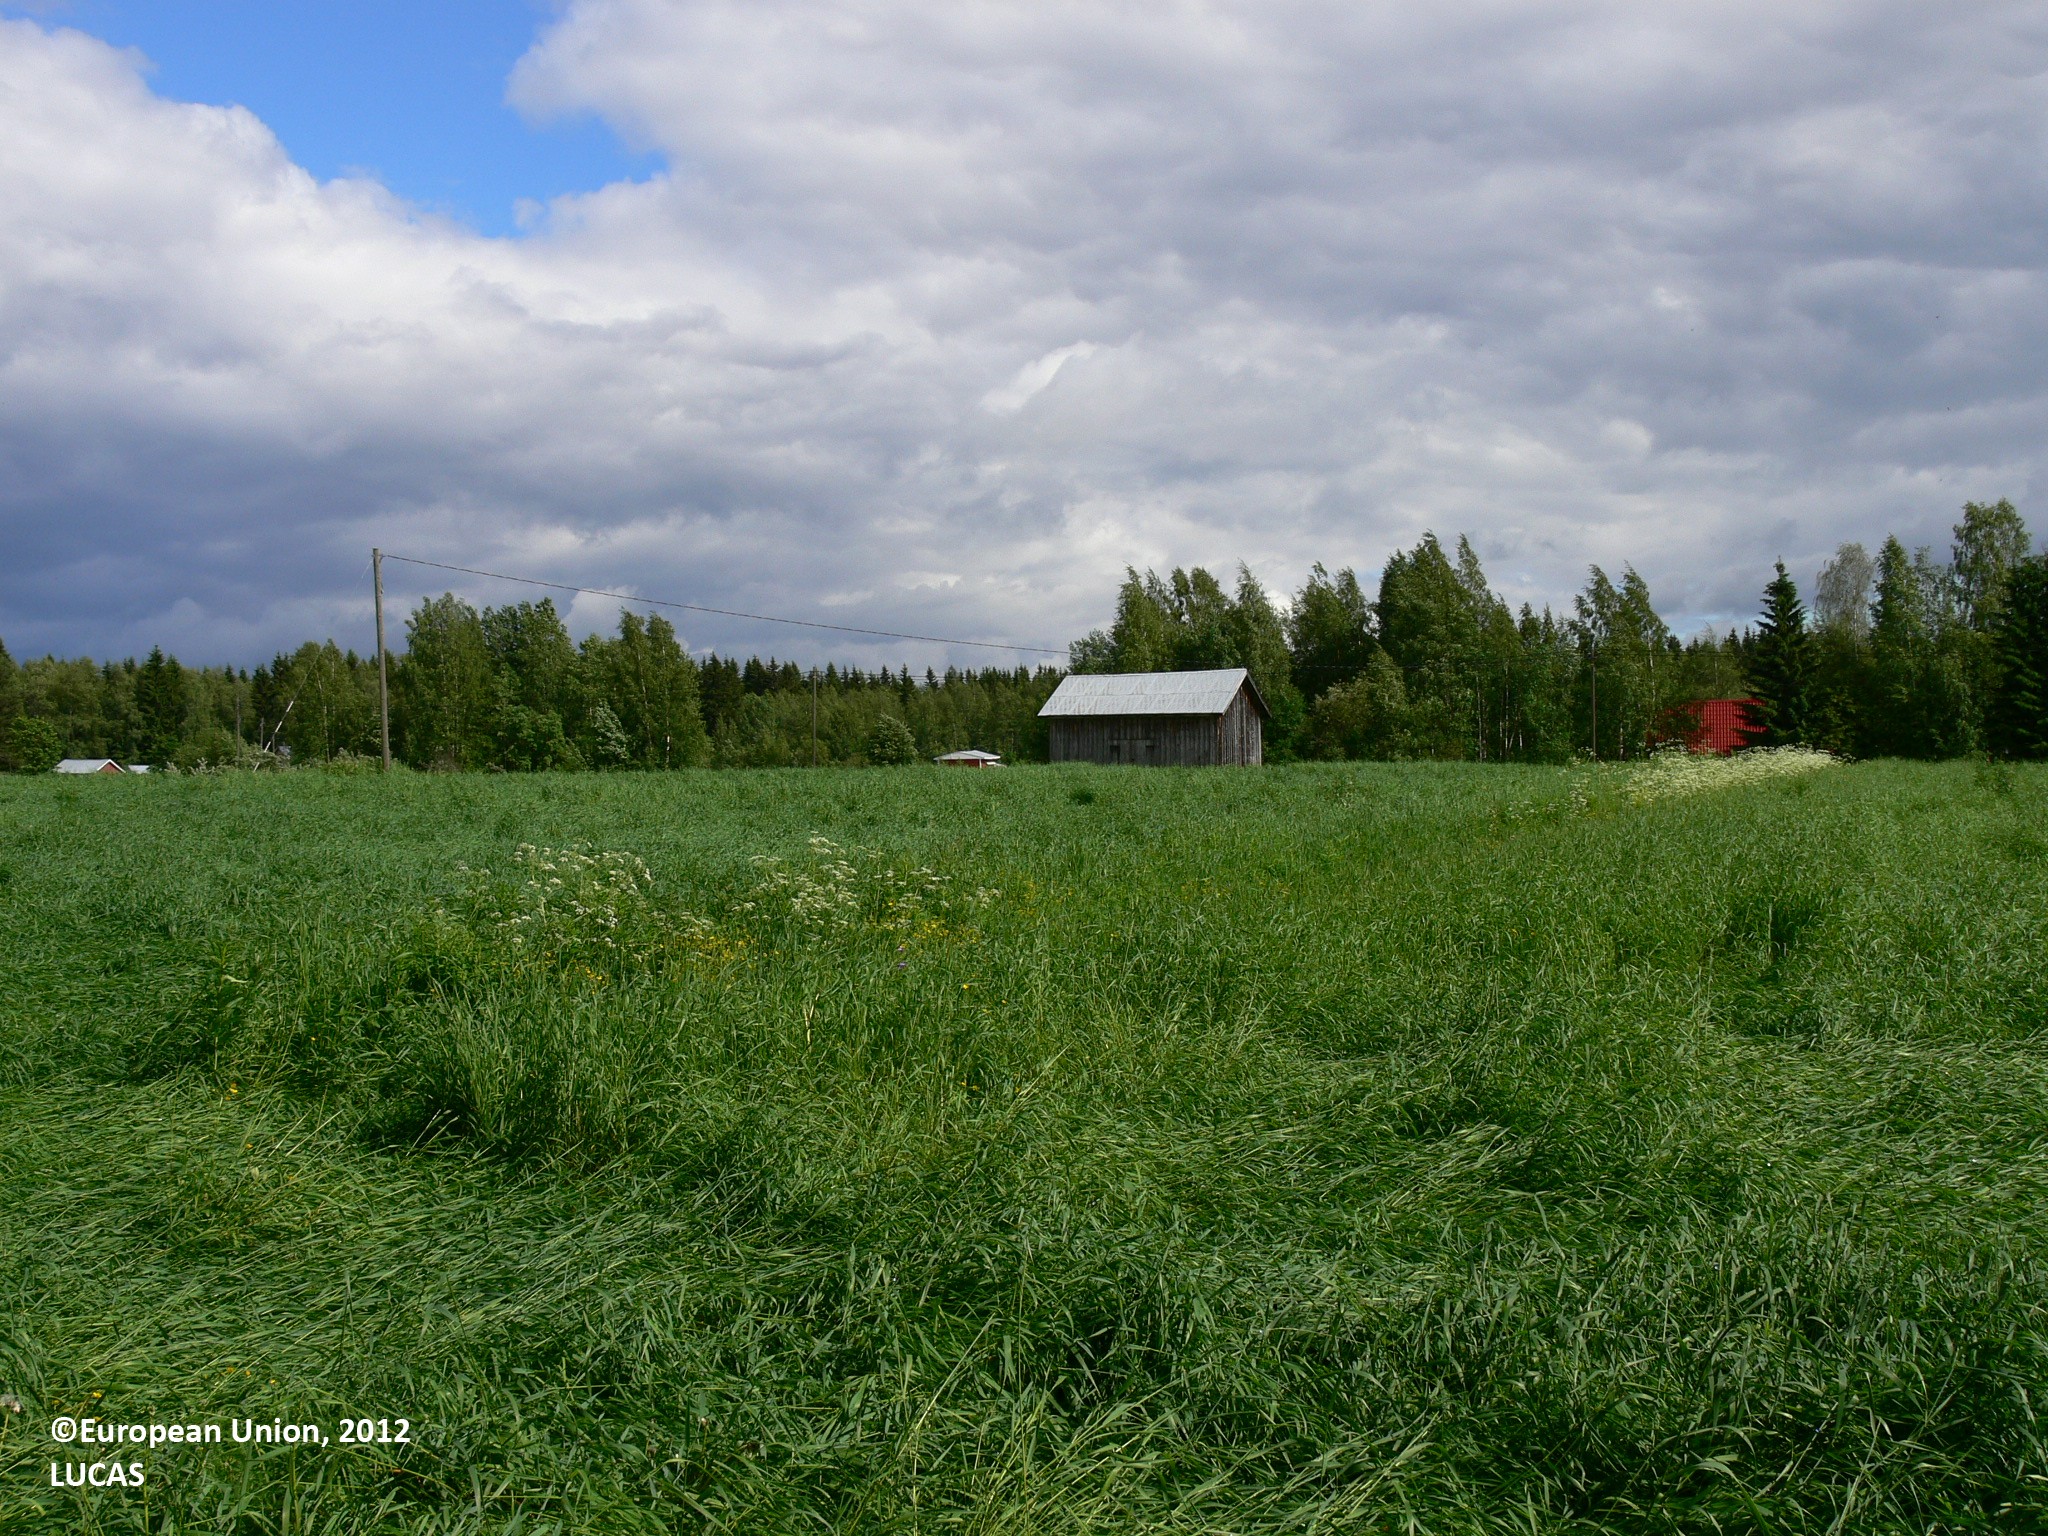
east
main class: Cropland
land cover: Temporary grasslands
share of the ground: > 75 %
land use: Agriculture (excluding fallow land and kitchen gardens)
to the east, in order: Temporary grasslands; Ditches and canals; Temporary grasslands; Electric lines; Temporary grasslands; Ditches and canals; Temporary grasslands
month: June
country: FI
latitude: 62.6567
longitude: 29.2550
